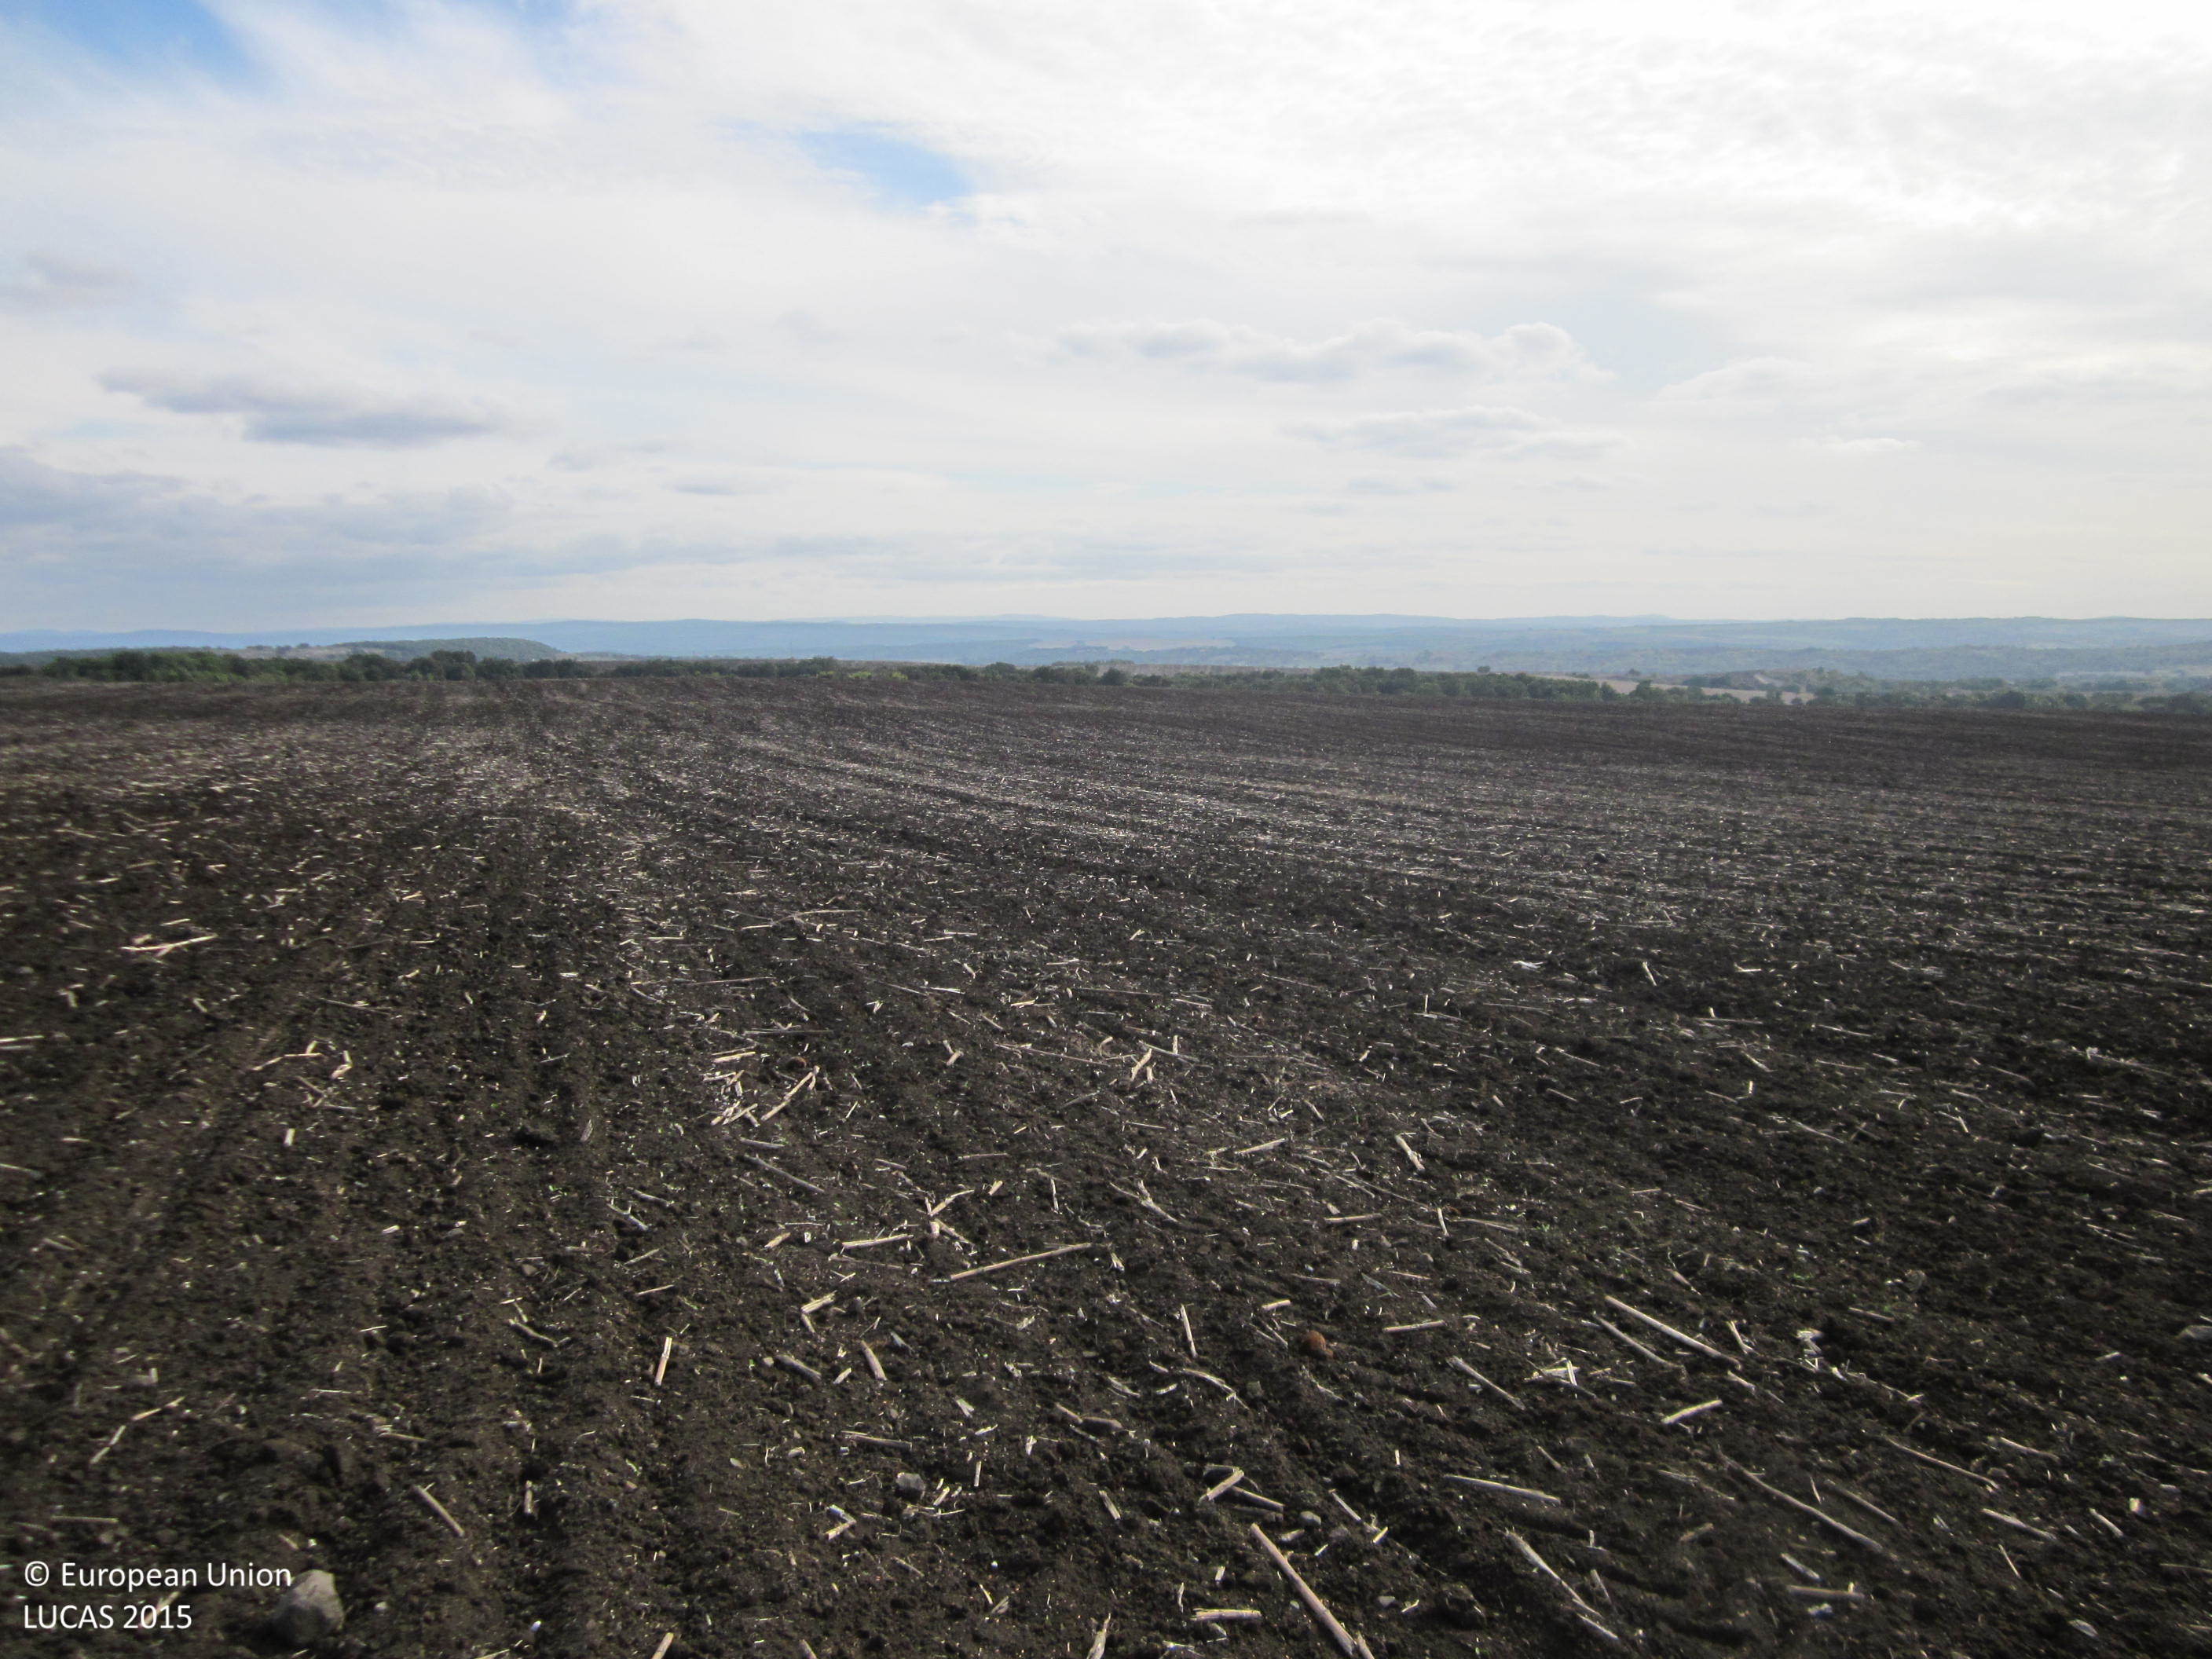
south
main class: Cropland
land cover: Sunflower
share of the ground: < 10 %
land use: Agriculture (excluding fallow land and kitchen gardens)
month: October
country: BG
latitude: 42.4278
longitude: 27.0608
